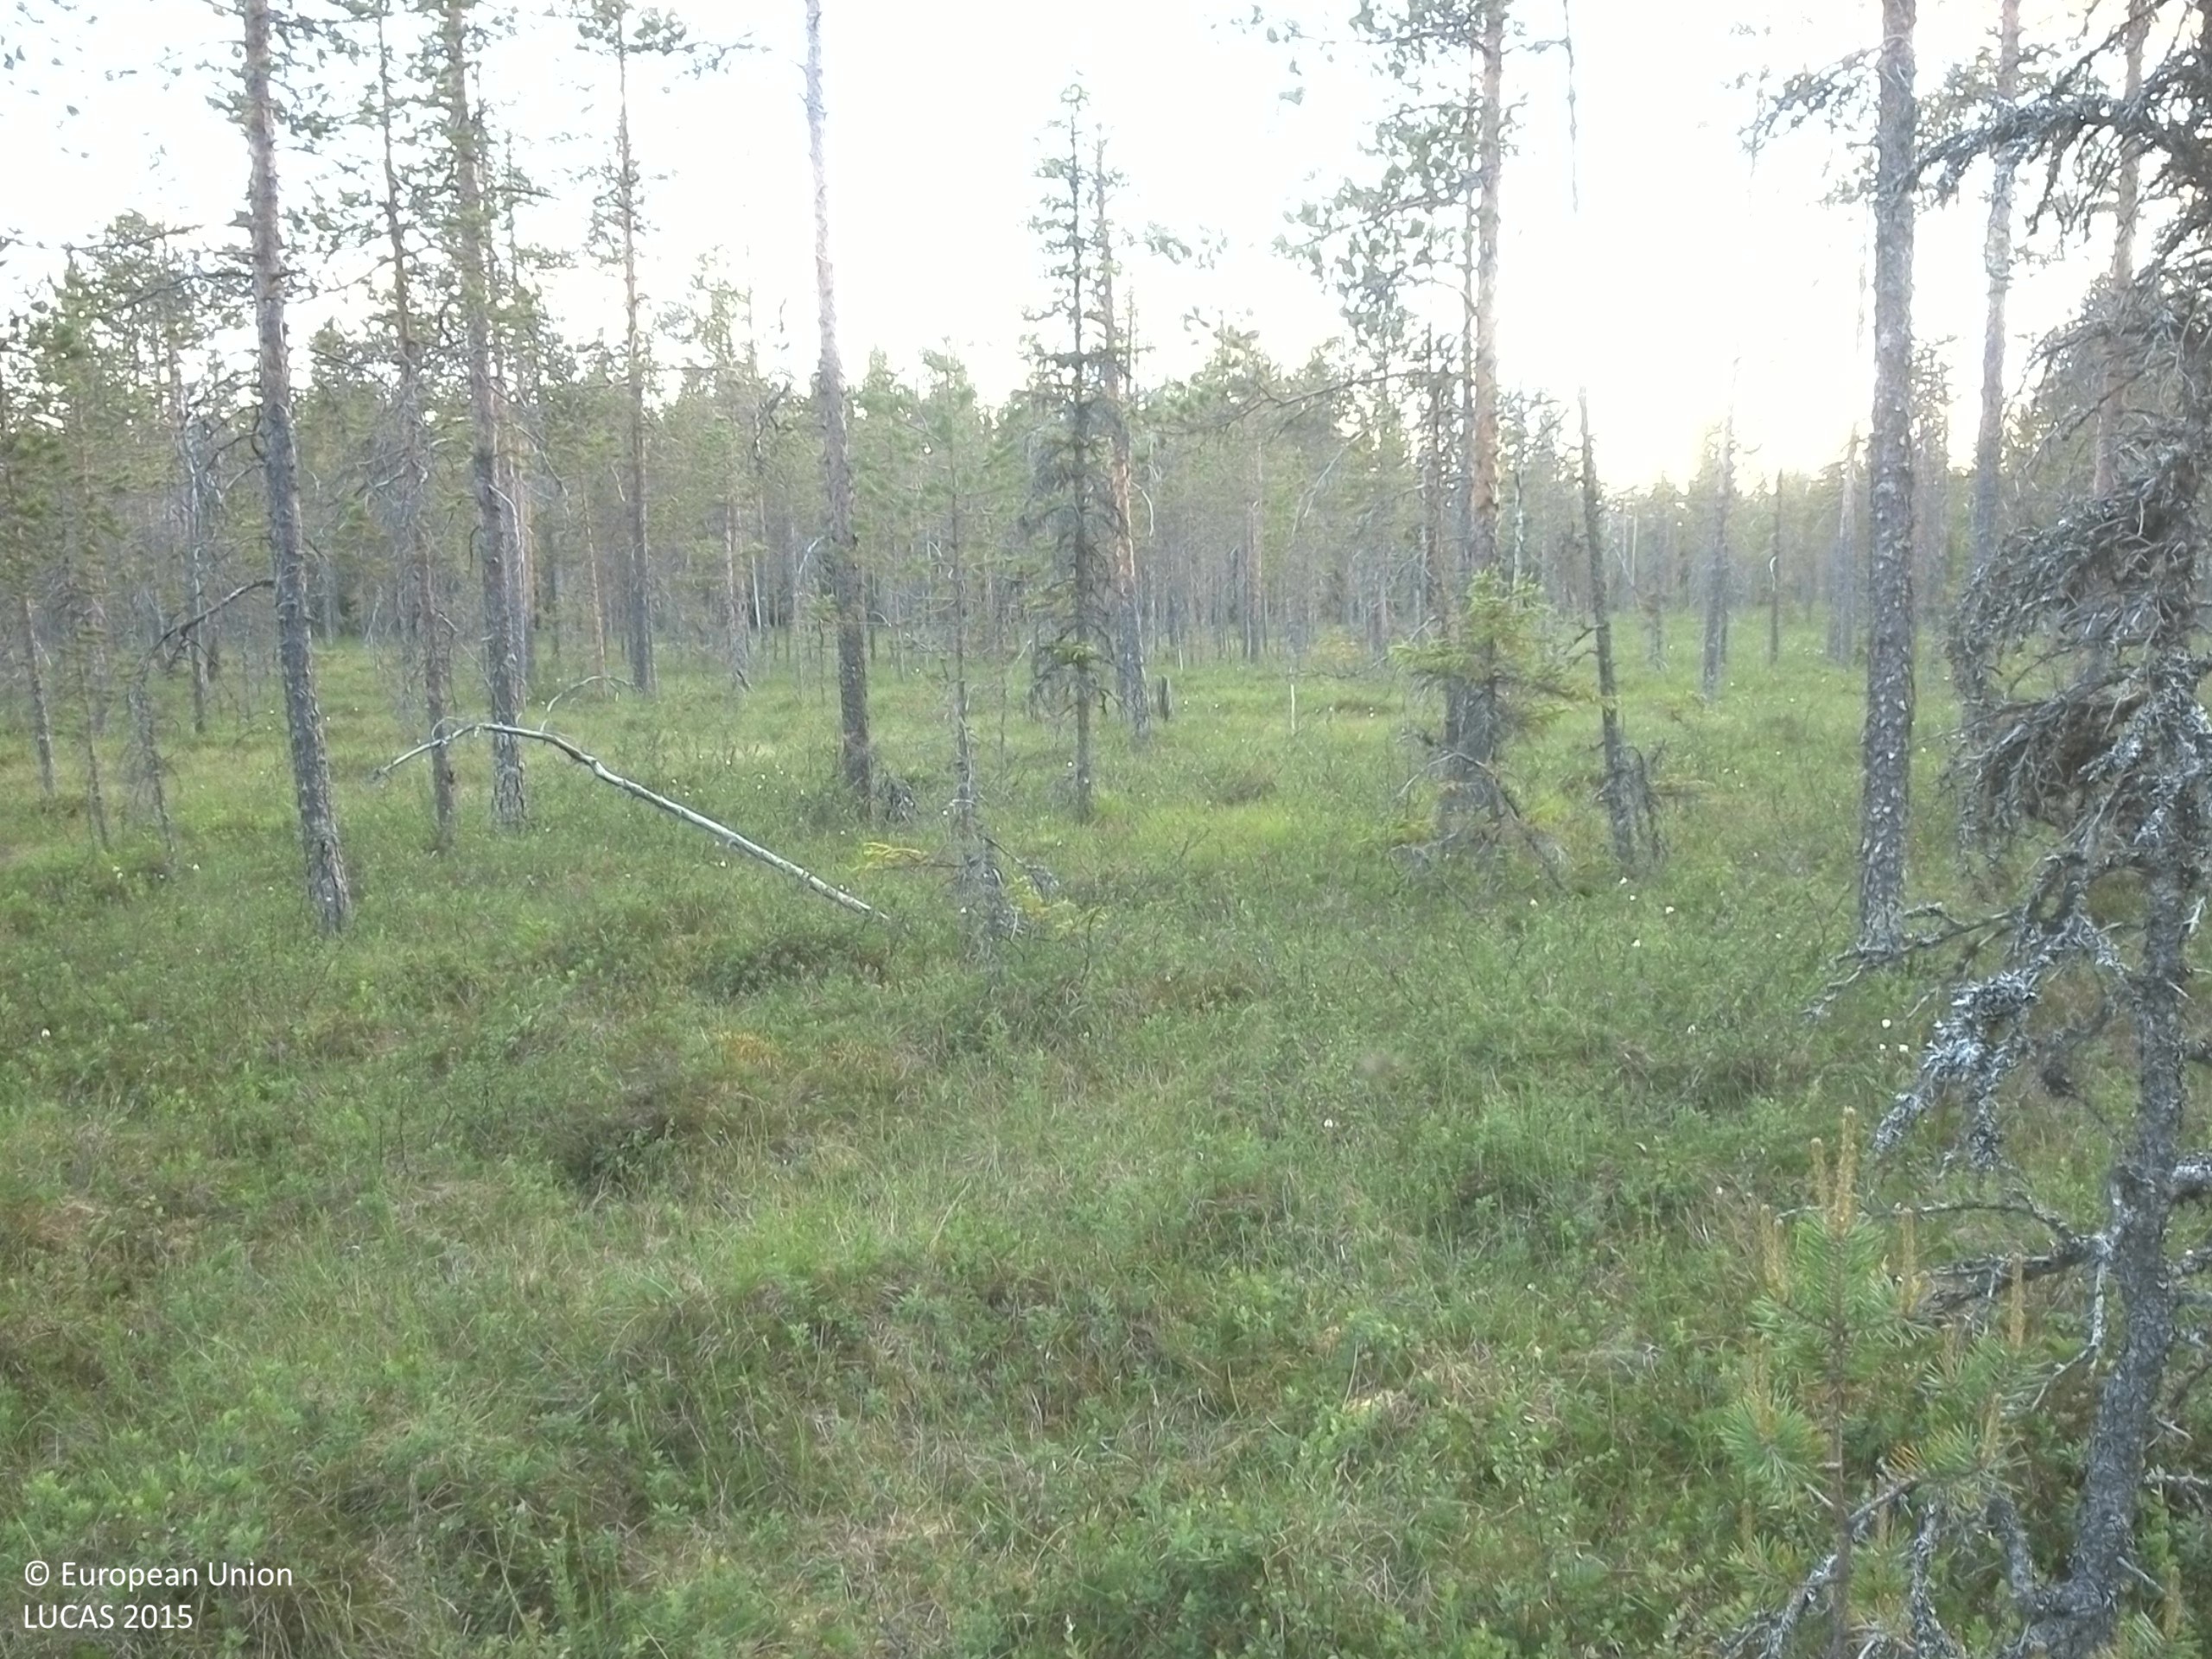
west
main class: Woodland
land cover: Pine dominated coniferous woodland
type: mire and swamp forests
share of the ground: 10 - 25 %
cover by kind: shrubs 55 %, lichens and mosses 20 %, herbaceous plants 15 %, coniferous forest trees 10 %
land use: Semi-natural and natural areas not in use
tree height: > 5 m
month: July
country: SE
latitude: 64.0713
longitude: 16.7960
